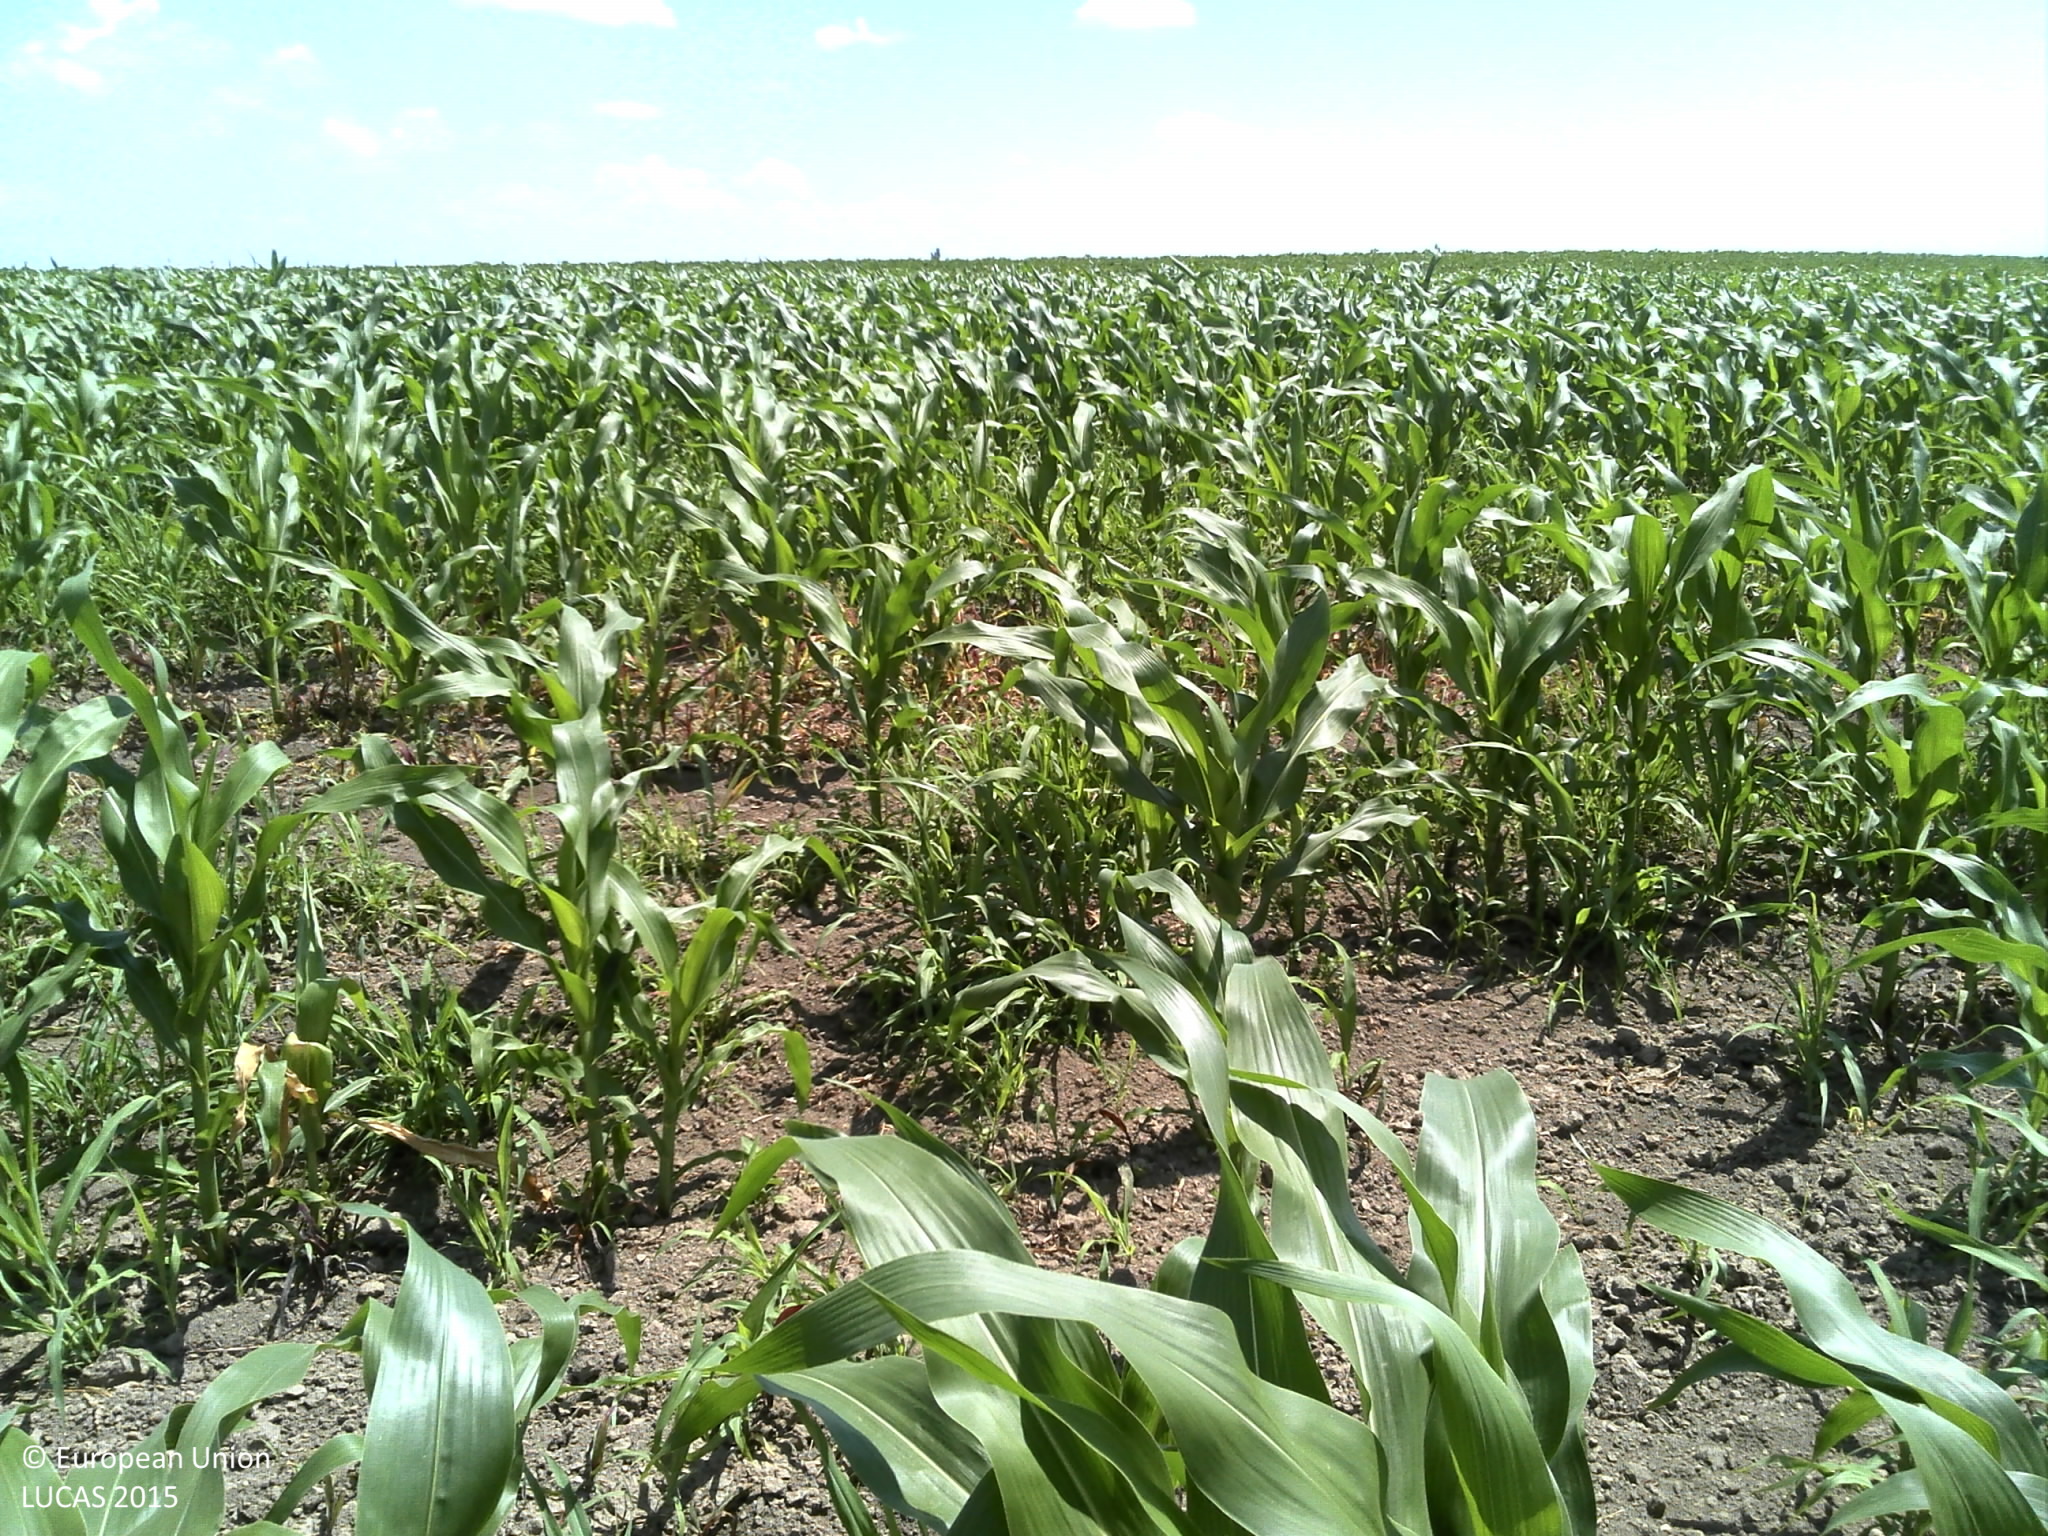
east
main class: Cropland
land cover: Maize
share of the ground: 25 - 50 %
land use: Agriculture (excluding fallow land and kitchen gardens)
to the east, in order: Maize; Sunflower; Sugar beet; Common wheat; Sunflower
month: June
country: HR
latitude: 45.7260
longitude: 18.6816
